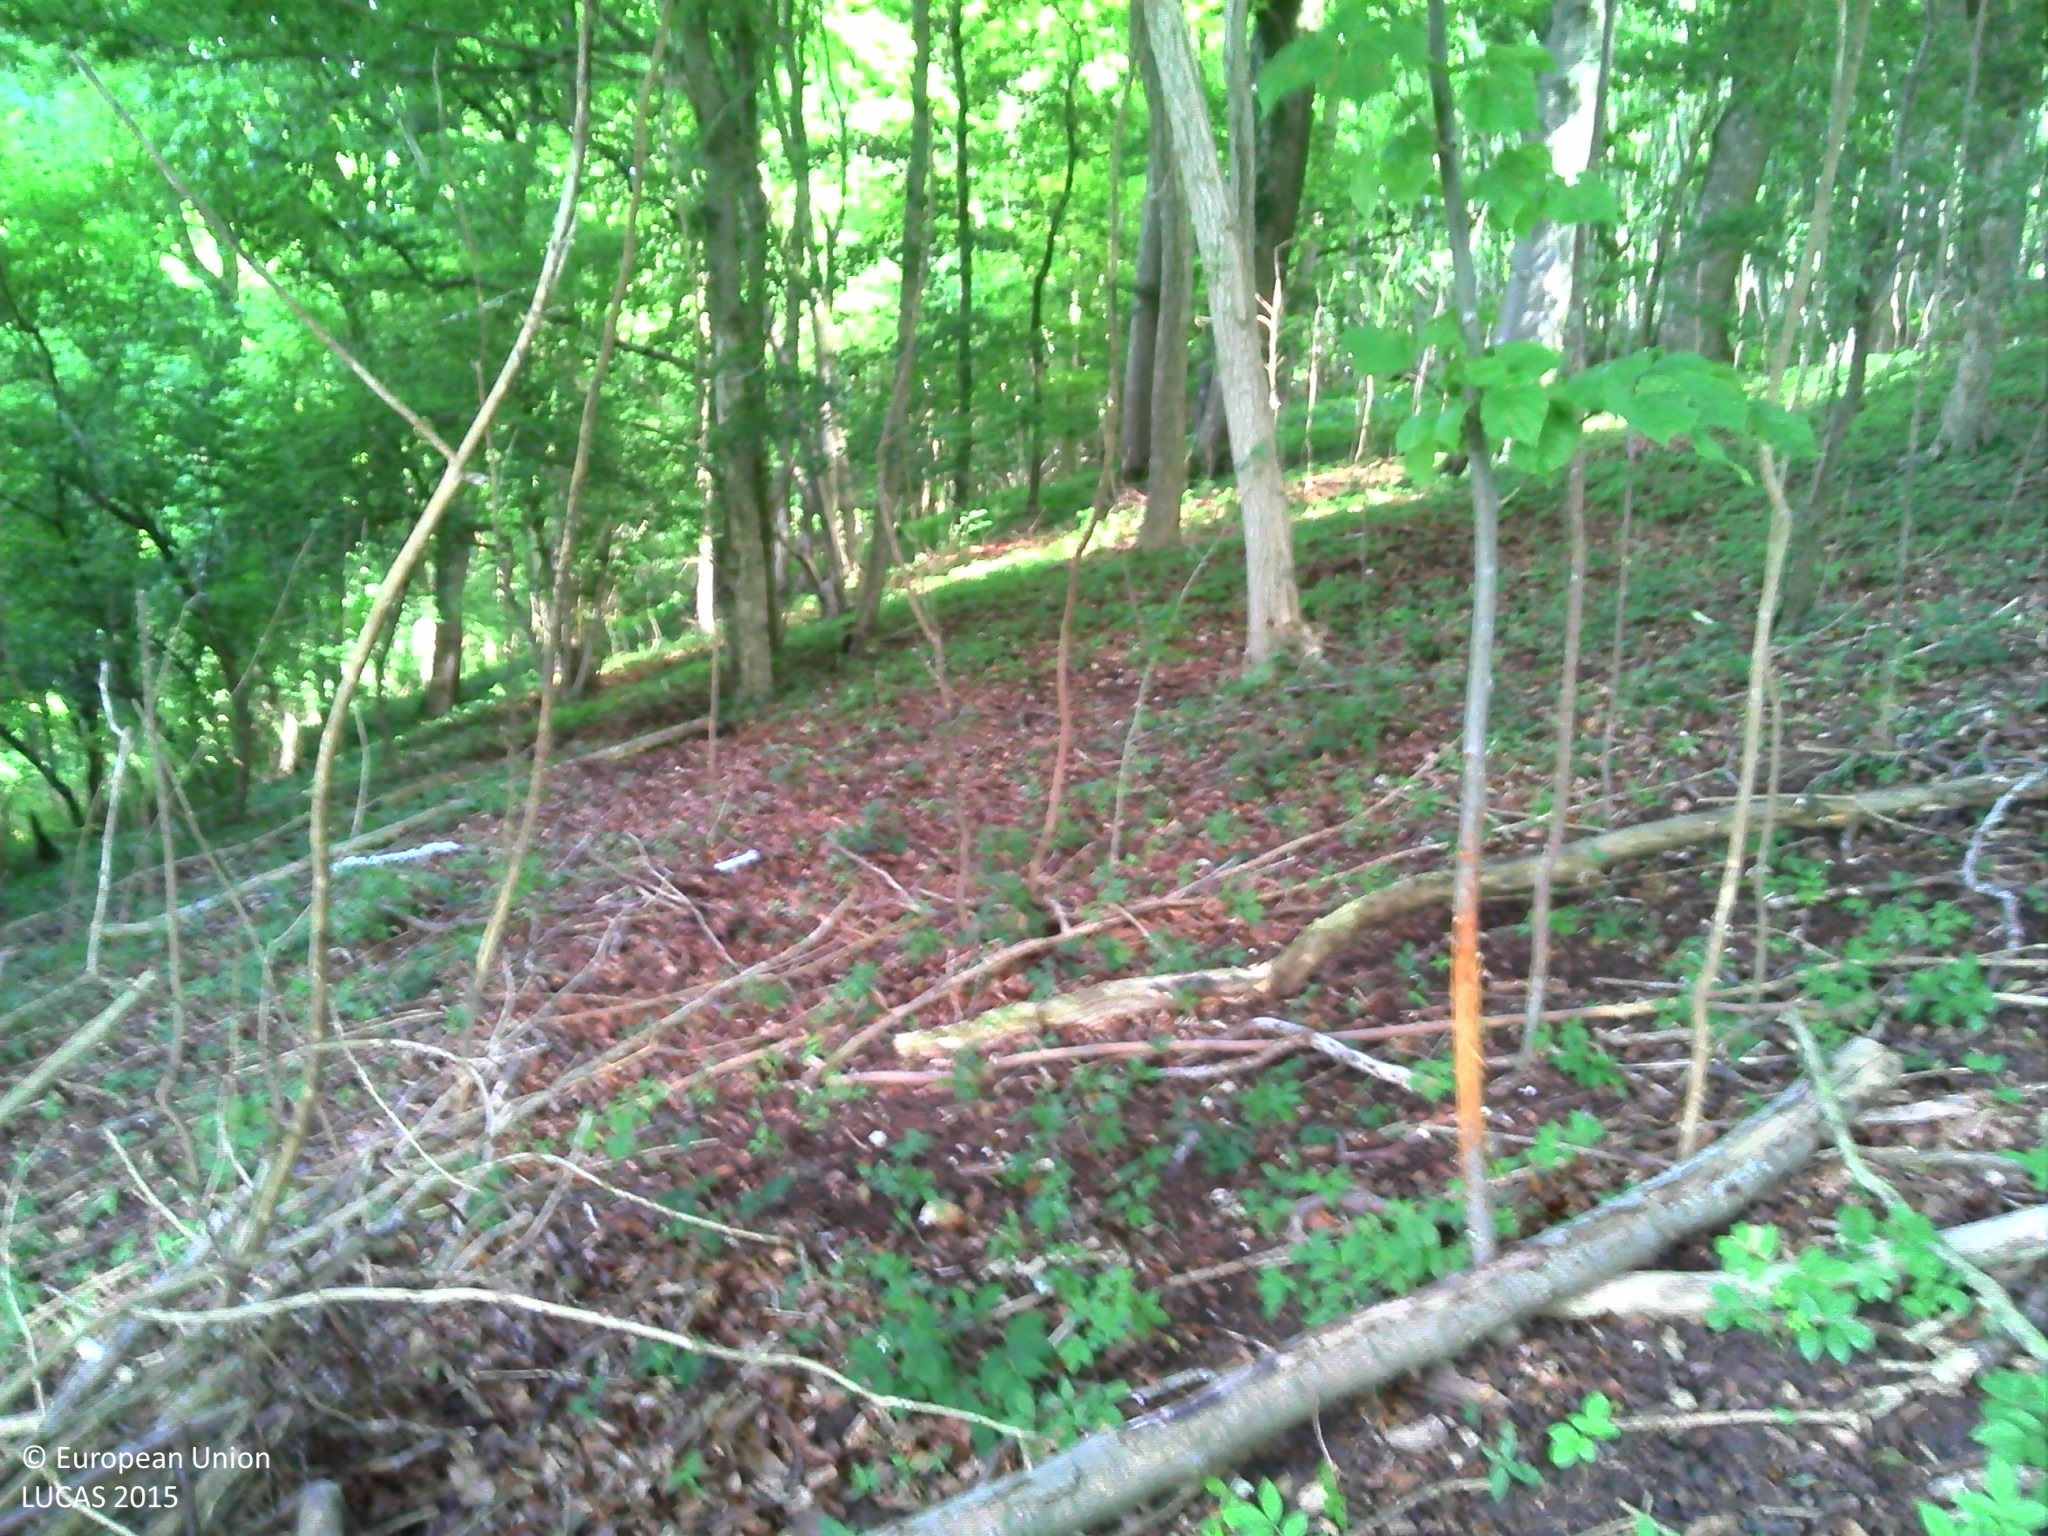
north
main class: Woodland
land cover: Broadleaved woodland
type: acidophilous oak and oak-birch forest
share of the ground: > 75 %
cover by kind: broadleaved forest trees 90 %, herbaceous plants 5 %, lichens and mosses 5 %
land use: Forestry
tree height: > 5 m
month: June
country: FR
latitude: 50.2018
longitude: 2.4075
